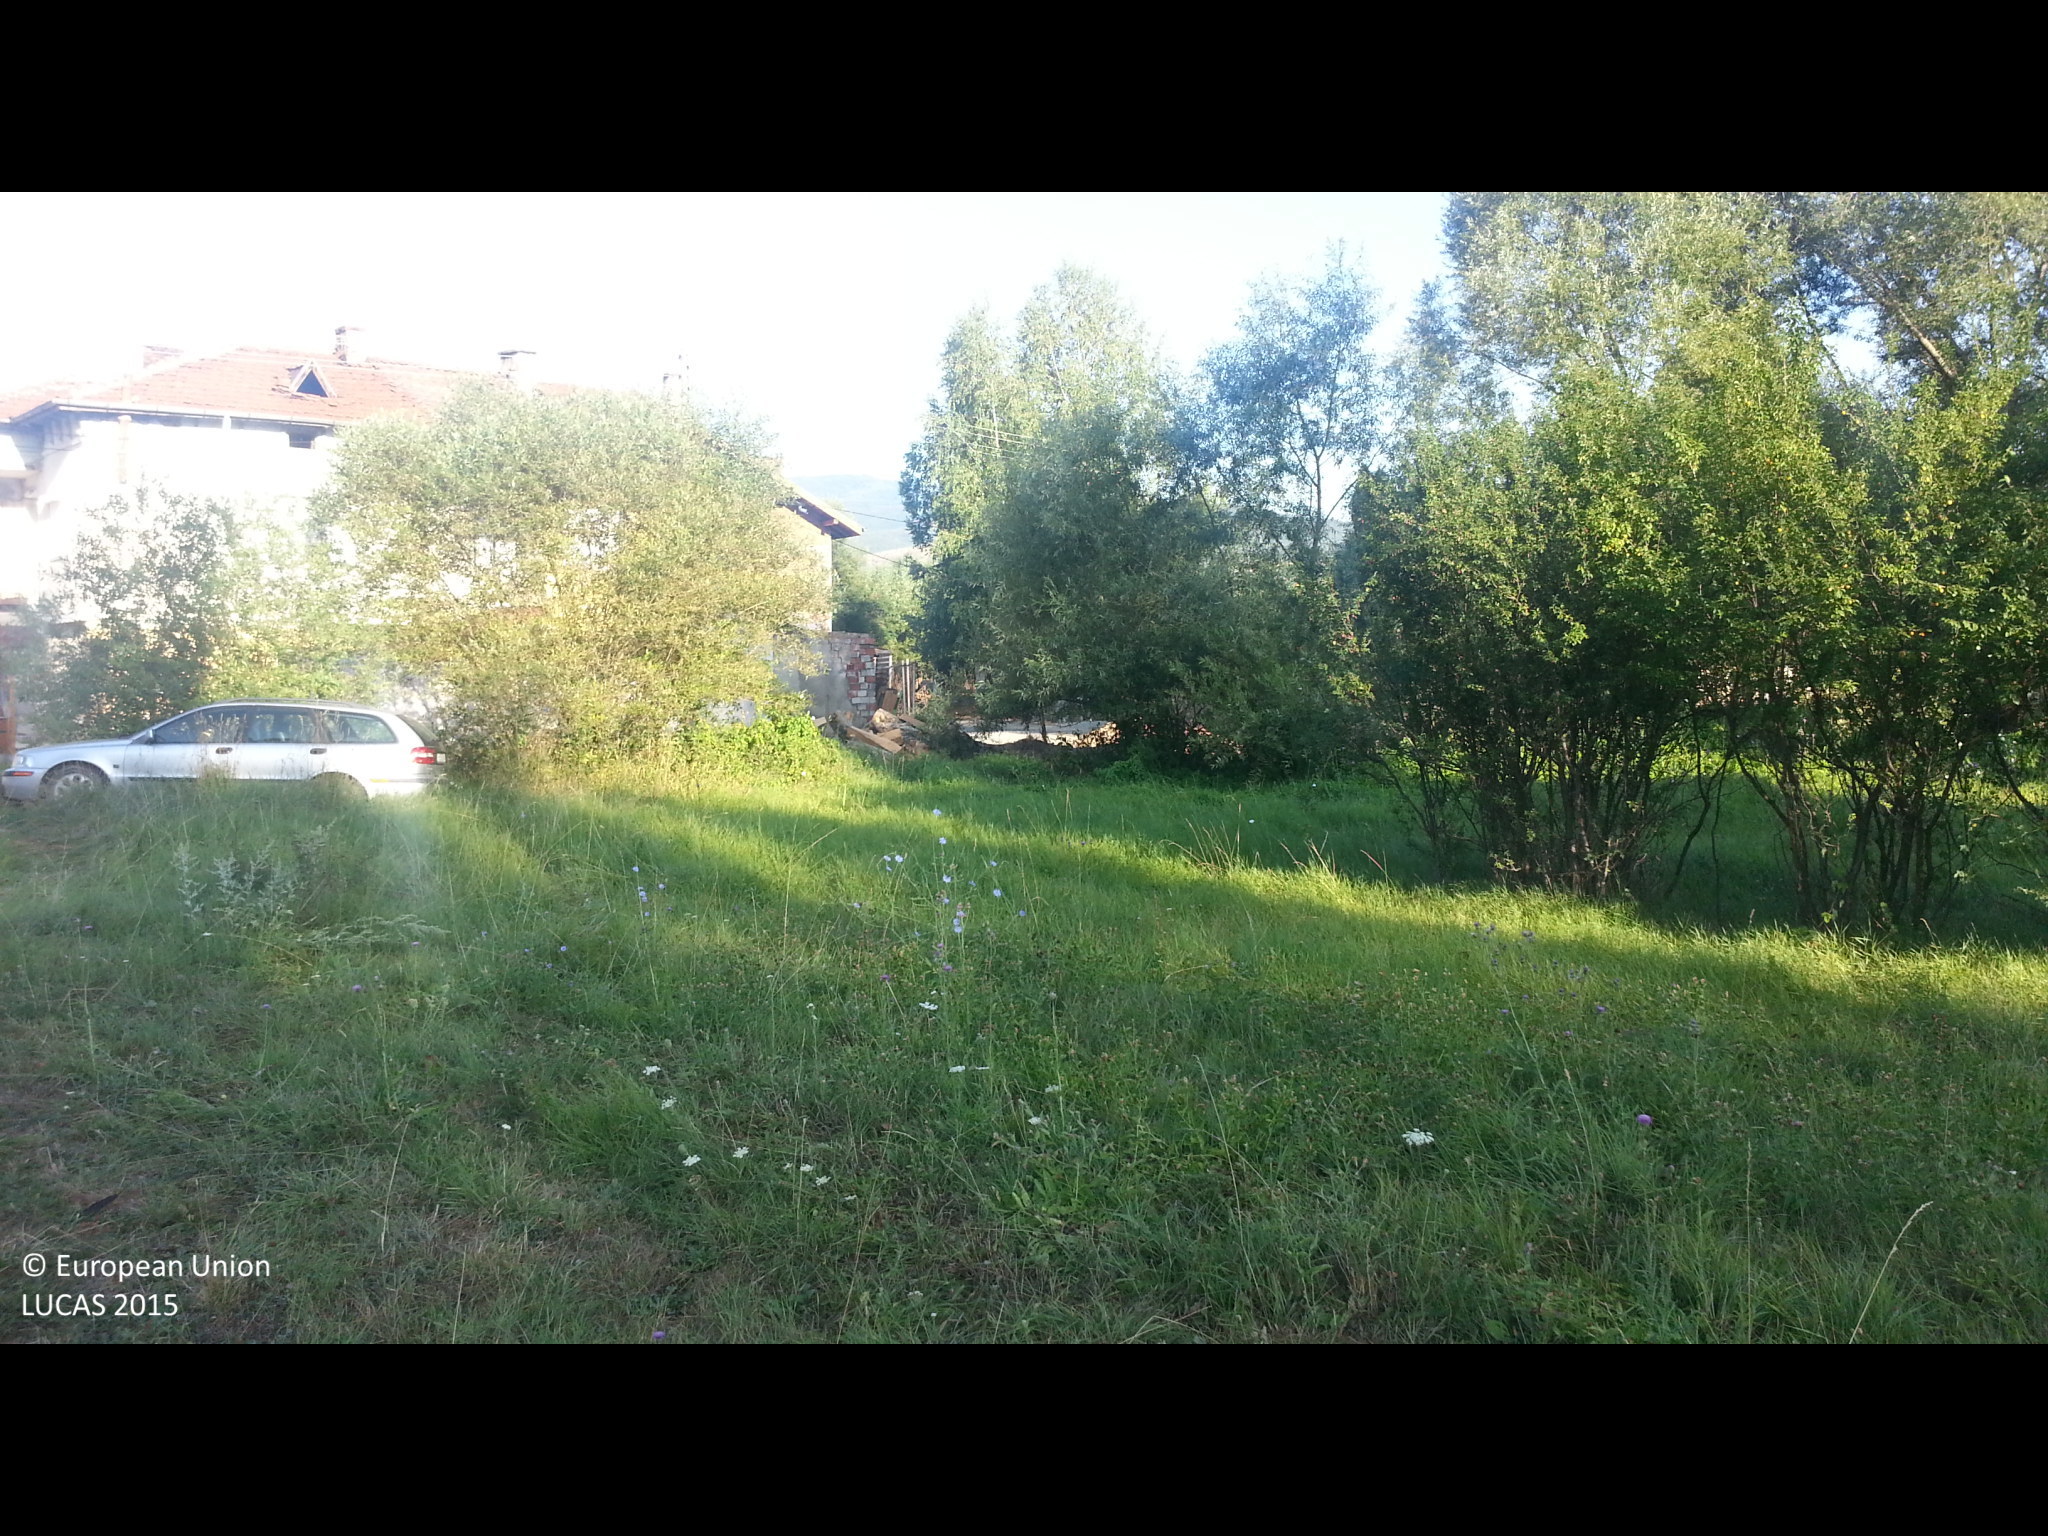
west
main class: Grassland
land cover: Grassland without tree/shrub cover
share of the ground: > 75 %
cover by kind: herbaceous plants 100 %
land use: Abandoned areas
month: August
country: BG
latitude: 42.2751
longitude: 22.6679
